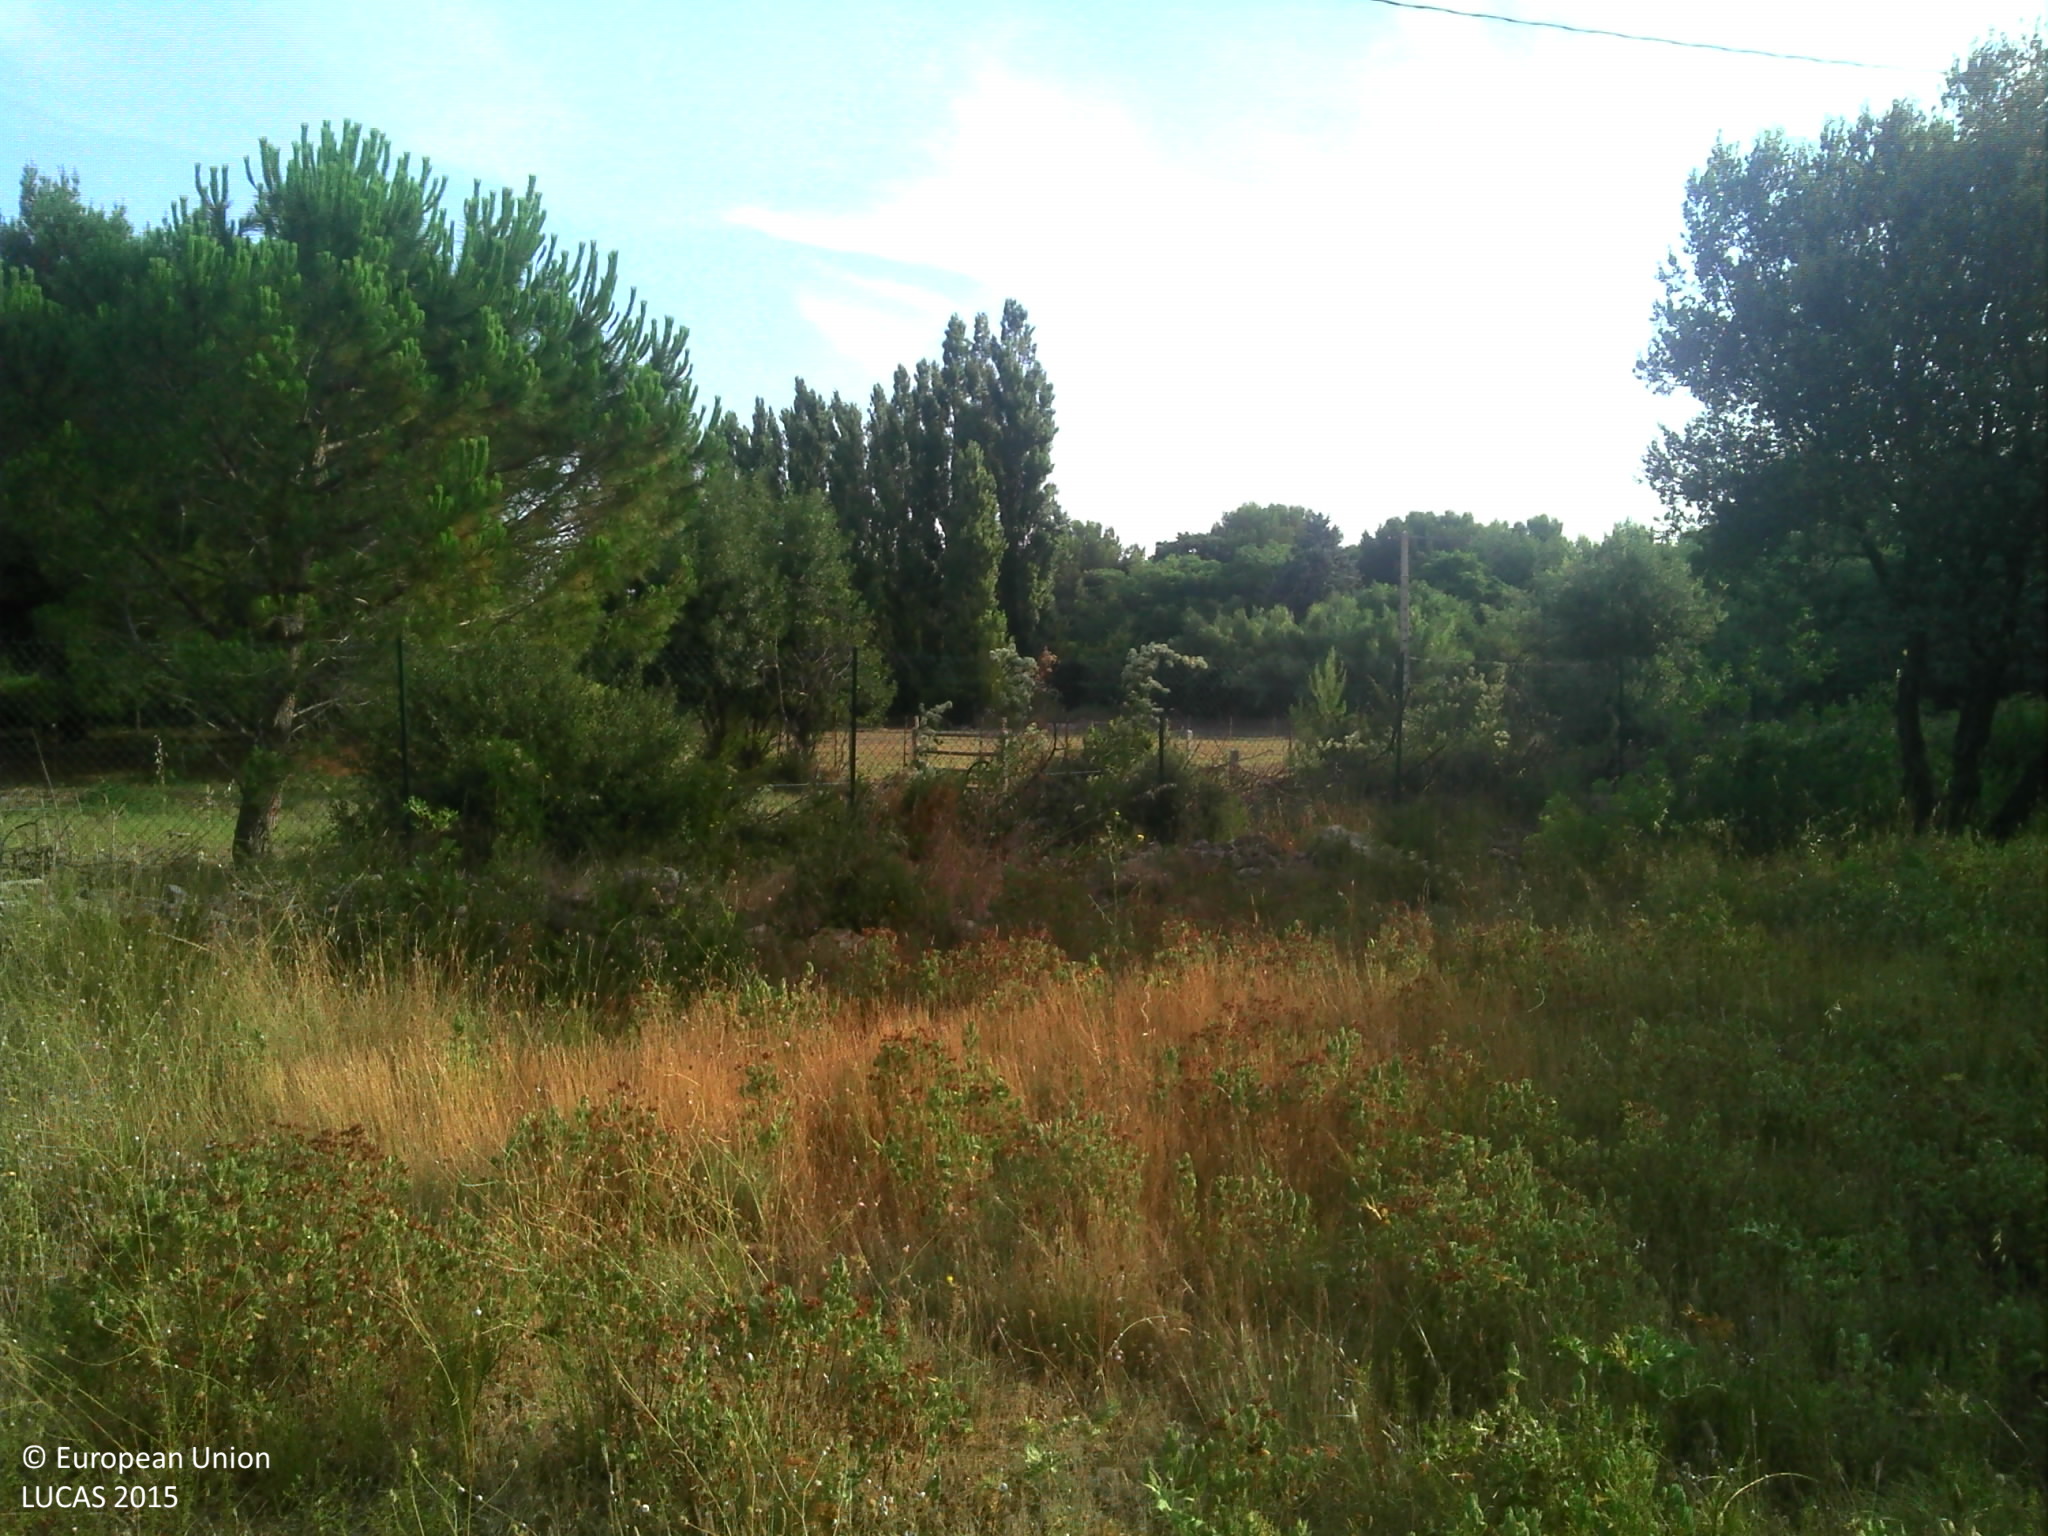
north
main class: Grassland
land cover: Grassland with sparse tree/shrub cover
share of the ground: > 75 %
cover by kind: herbaceous plants 75 %, coniferous forest trees 5 %, shrubs 5 %, consolidated bare surface 5 %
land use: Abandoned areas
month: July
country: FR
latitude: 43.6019
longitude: 5.0914
